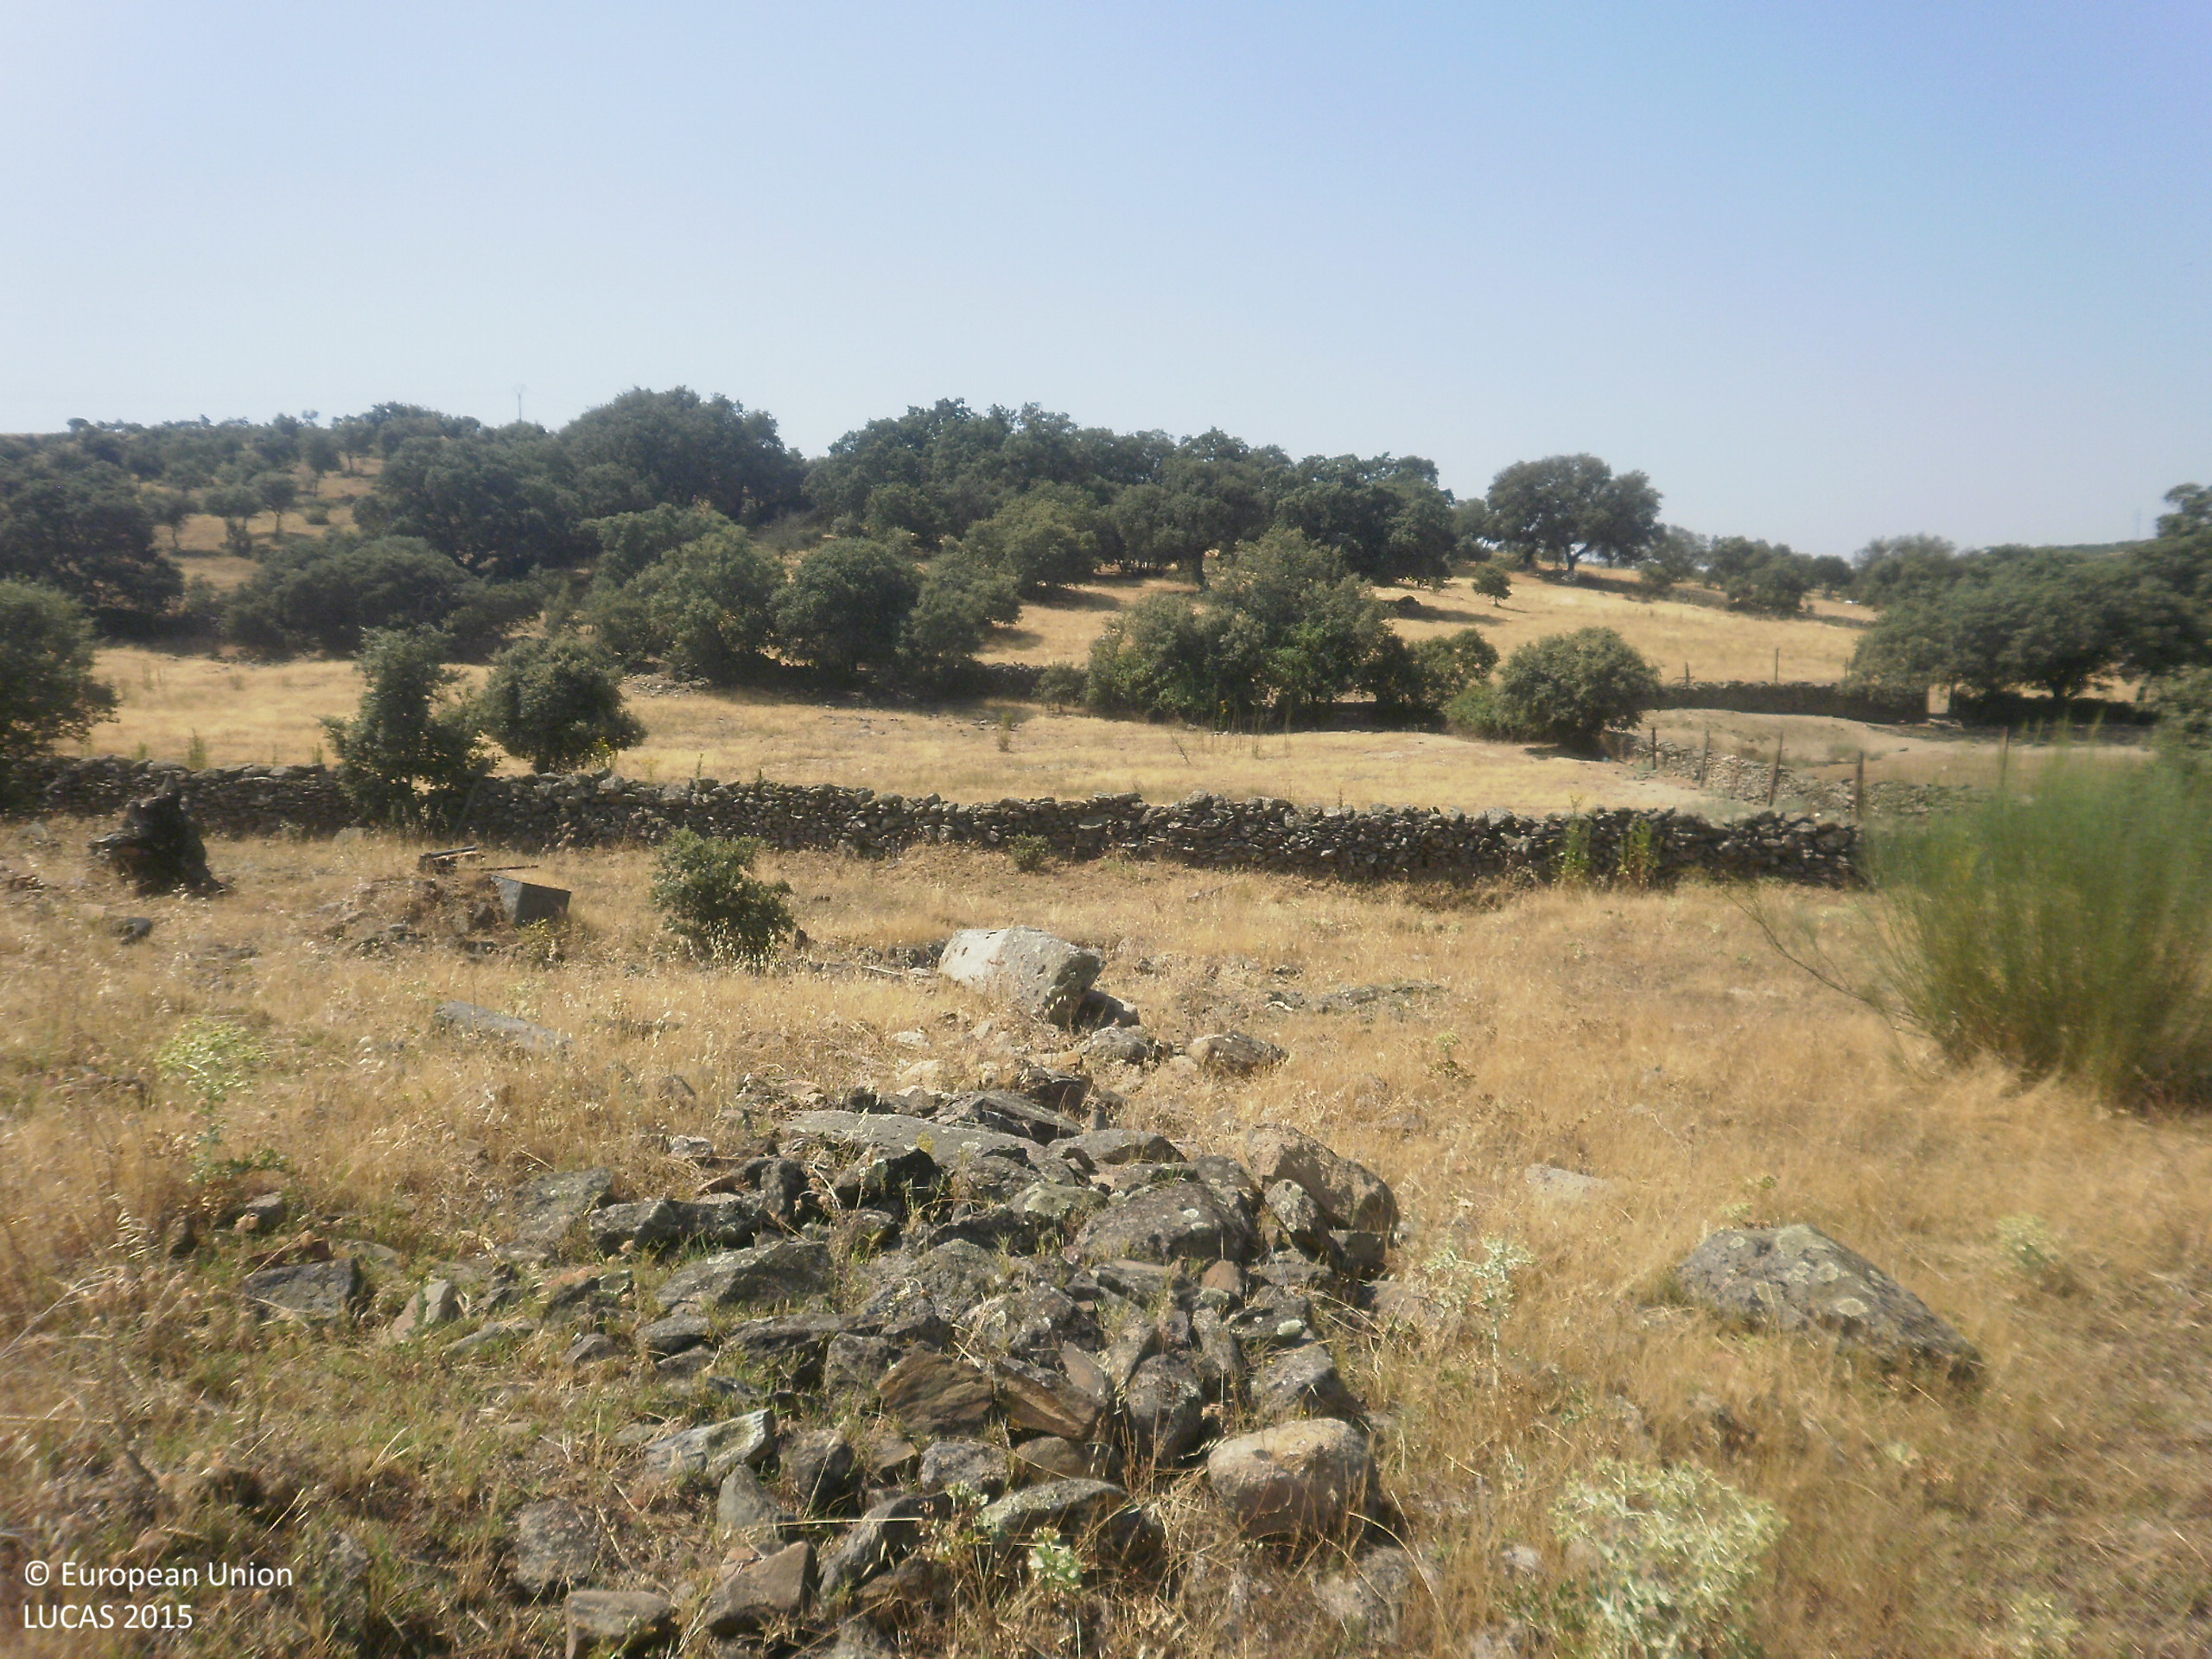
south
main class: Grassland
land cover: Grassland with sparse tree/shrub cover
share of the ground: > 75 %
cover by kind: herbaceous plants 90 %, broadleaved forest trees 5 %, shrubs 5 %
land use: Agriculture (excluding fallow land and kitchen gardens)
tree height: > 5 m
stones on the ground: < 10 %
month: June
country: ES
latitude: 39.1679
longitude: -5.8750
